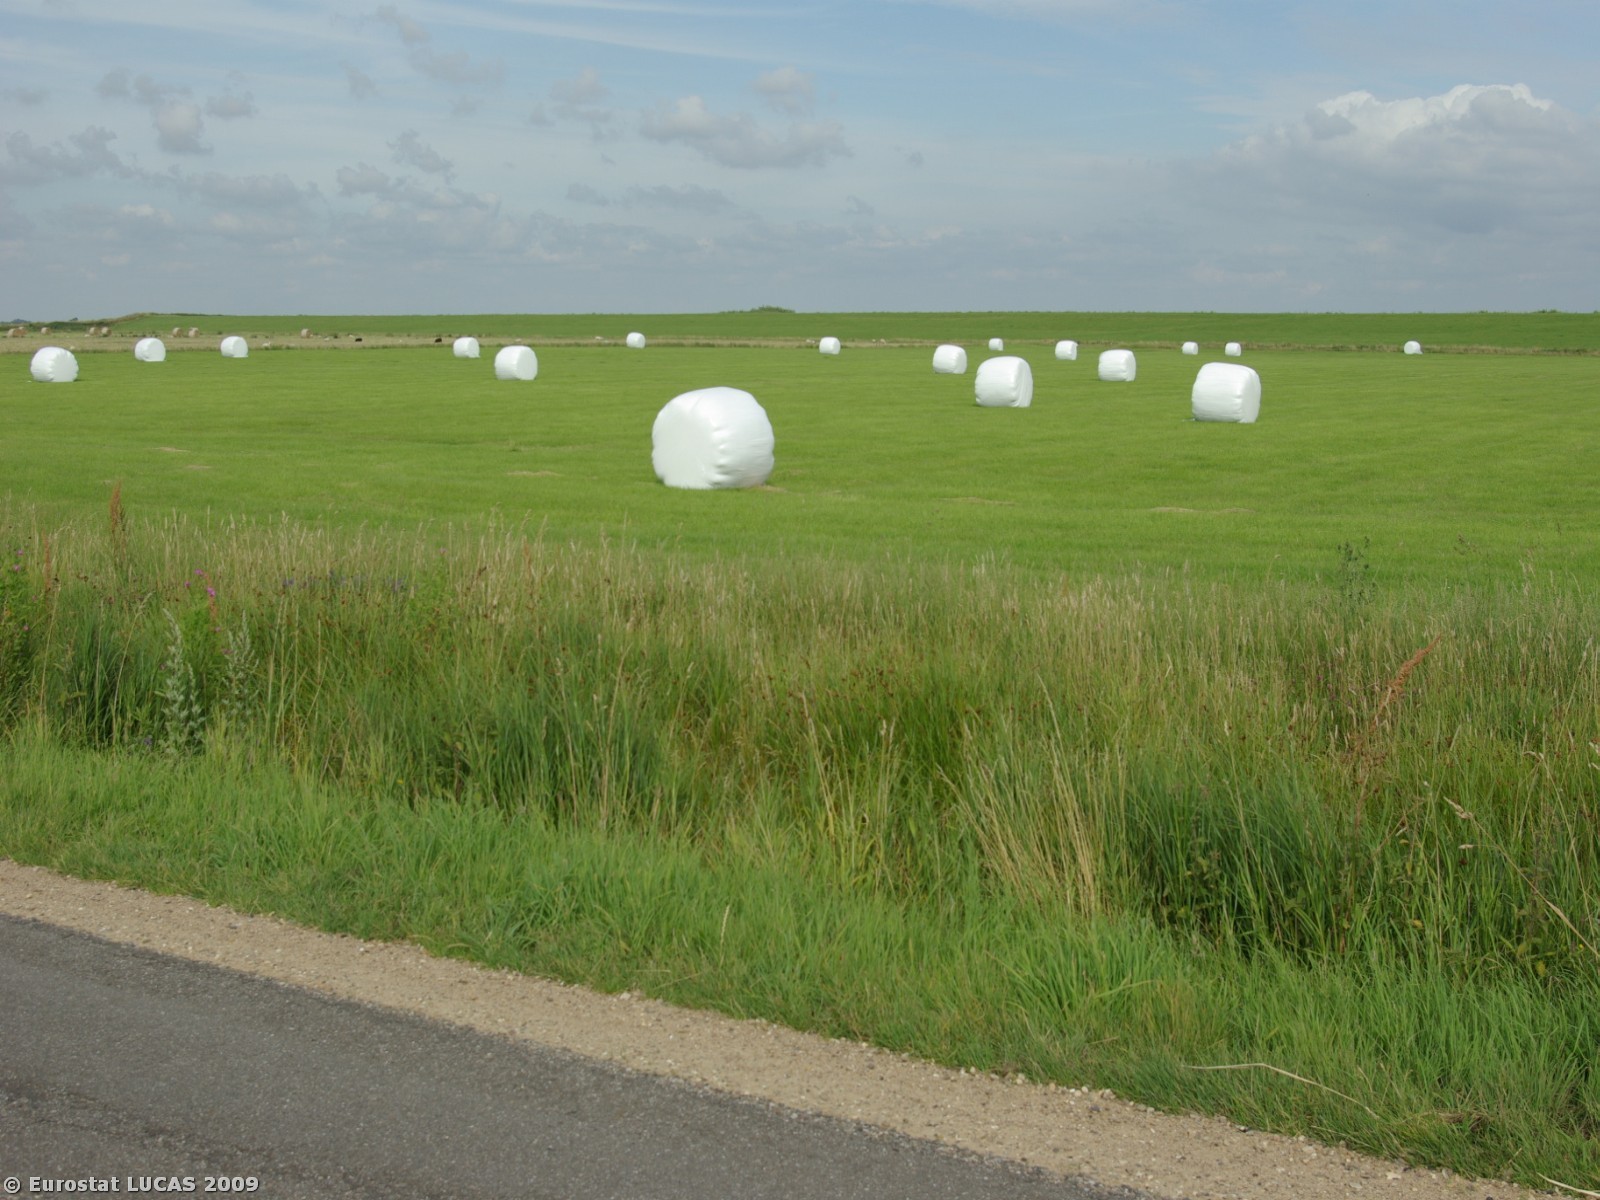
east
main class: Cropland
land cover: Common wheat
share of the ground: > 75 %
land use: Agriculture (excluding fallow land and kitchen gardens)
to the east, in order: Common wheat; Shruby margins; Ditches and canals; Shruby margins; Common wheat; Spontaneously vegetated surfaces; Grass margins; Tracks; Grass margins; Ditches and canals; Grass margins; Grassland without tree/shrub cover
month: July
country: DK
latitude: 54.9225
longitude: 8.6747
